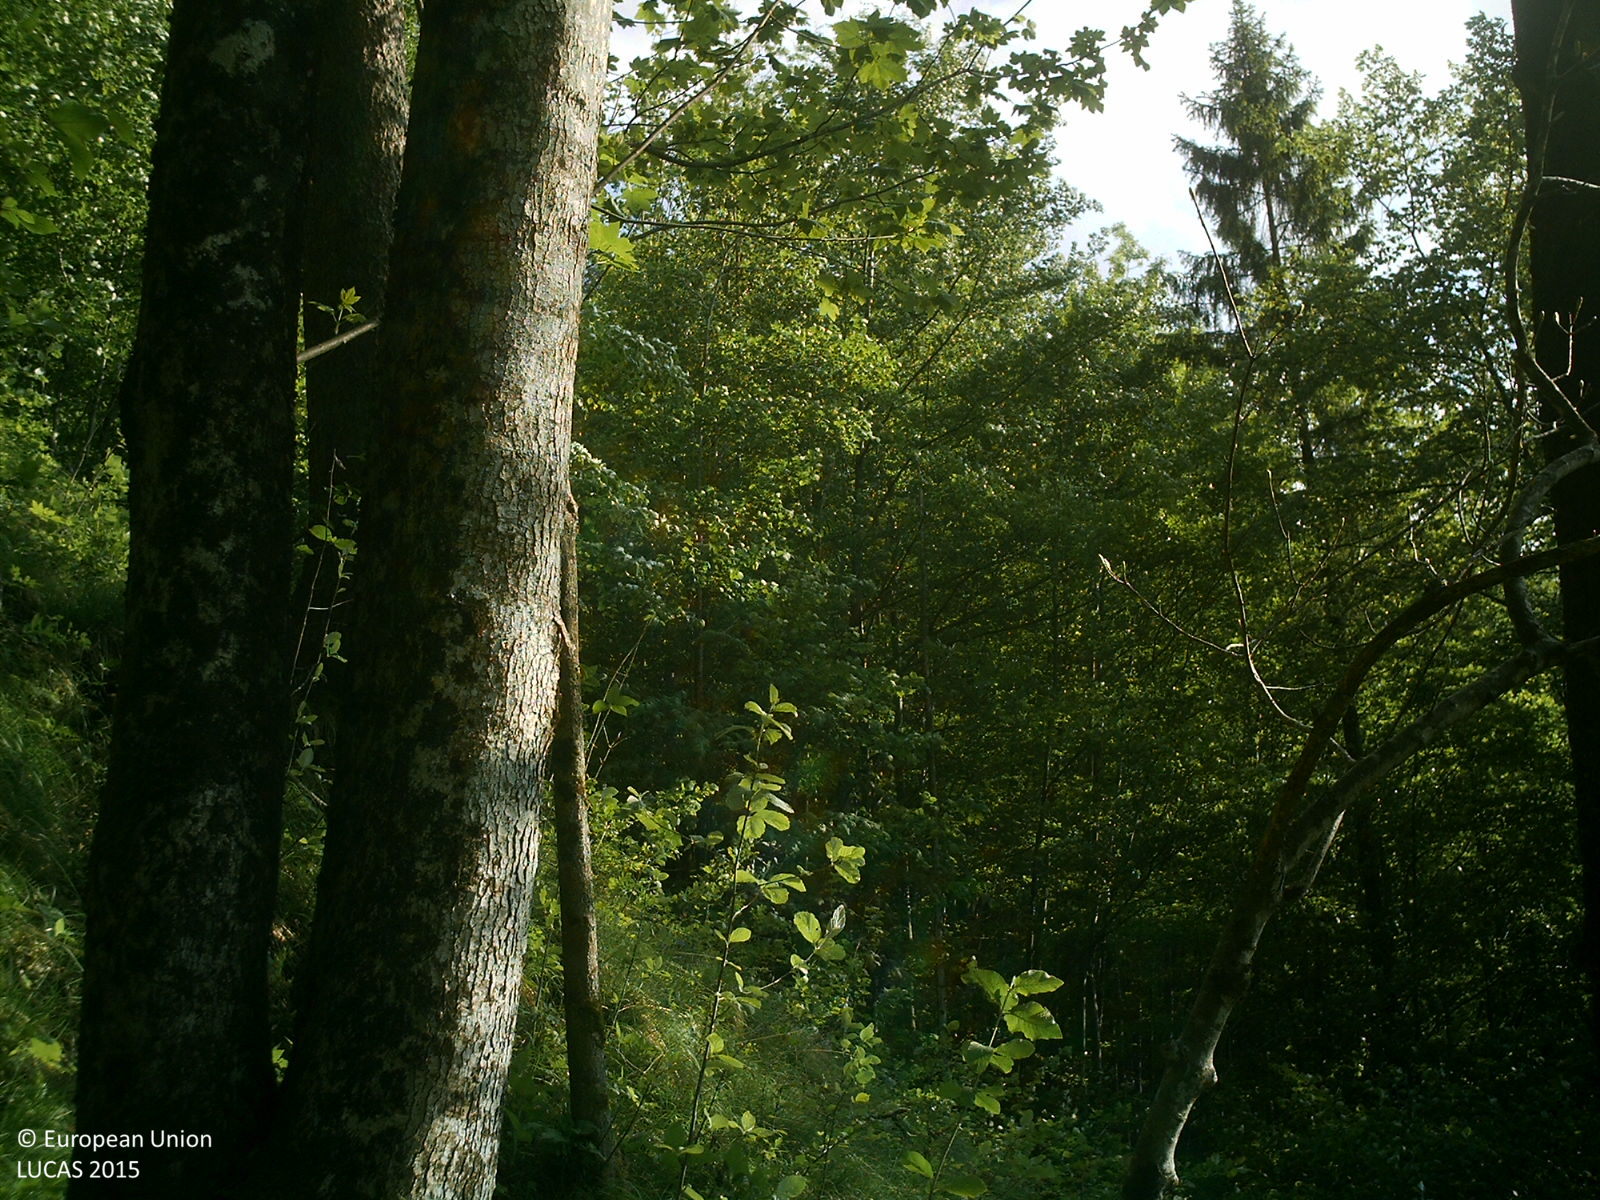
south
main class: Woodland
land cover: Other mixed woodland
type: mountainous beech forest
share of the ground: > 75 %
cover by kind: broadleaved forest trees 60 %, coniferous forest trees 35 %, shrubs 5 %
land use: Forestry
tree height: > 5 m
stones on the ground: < 10 %
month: May
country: AT
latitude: 47.8877
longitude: 14.2925
